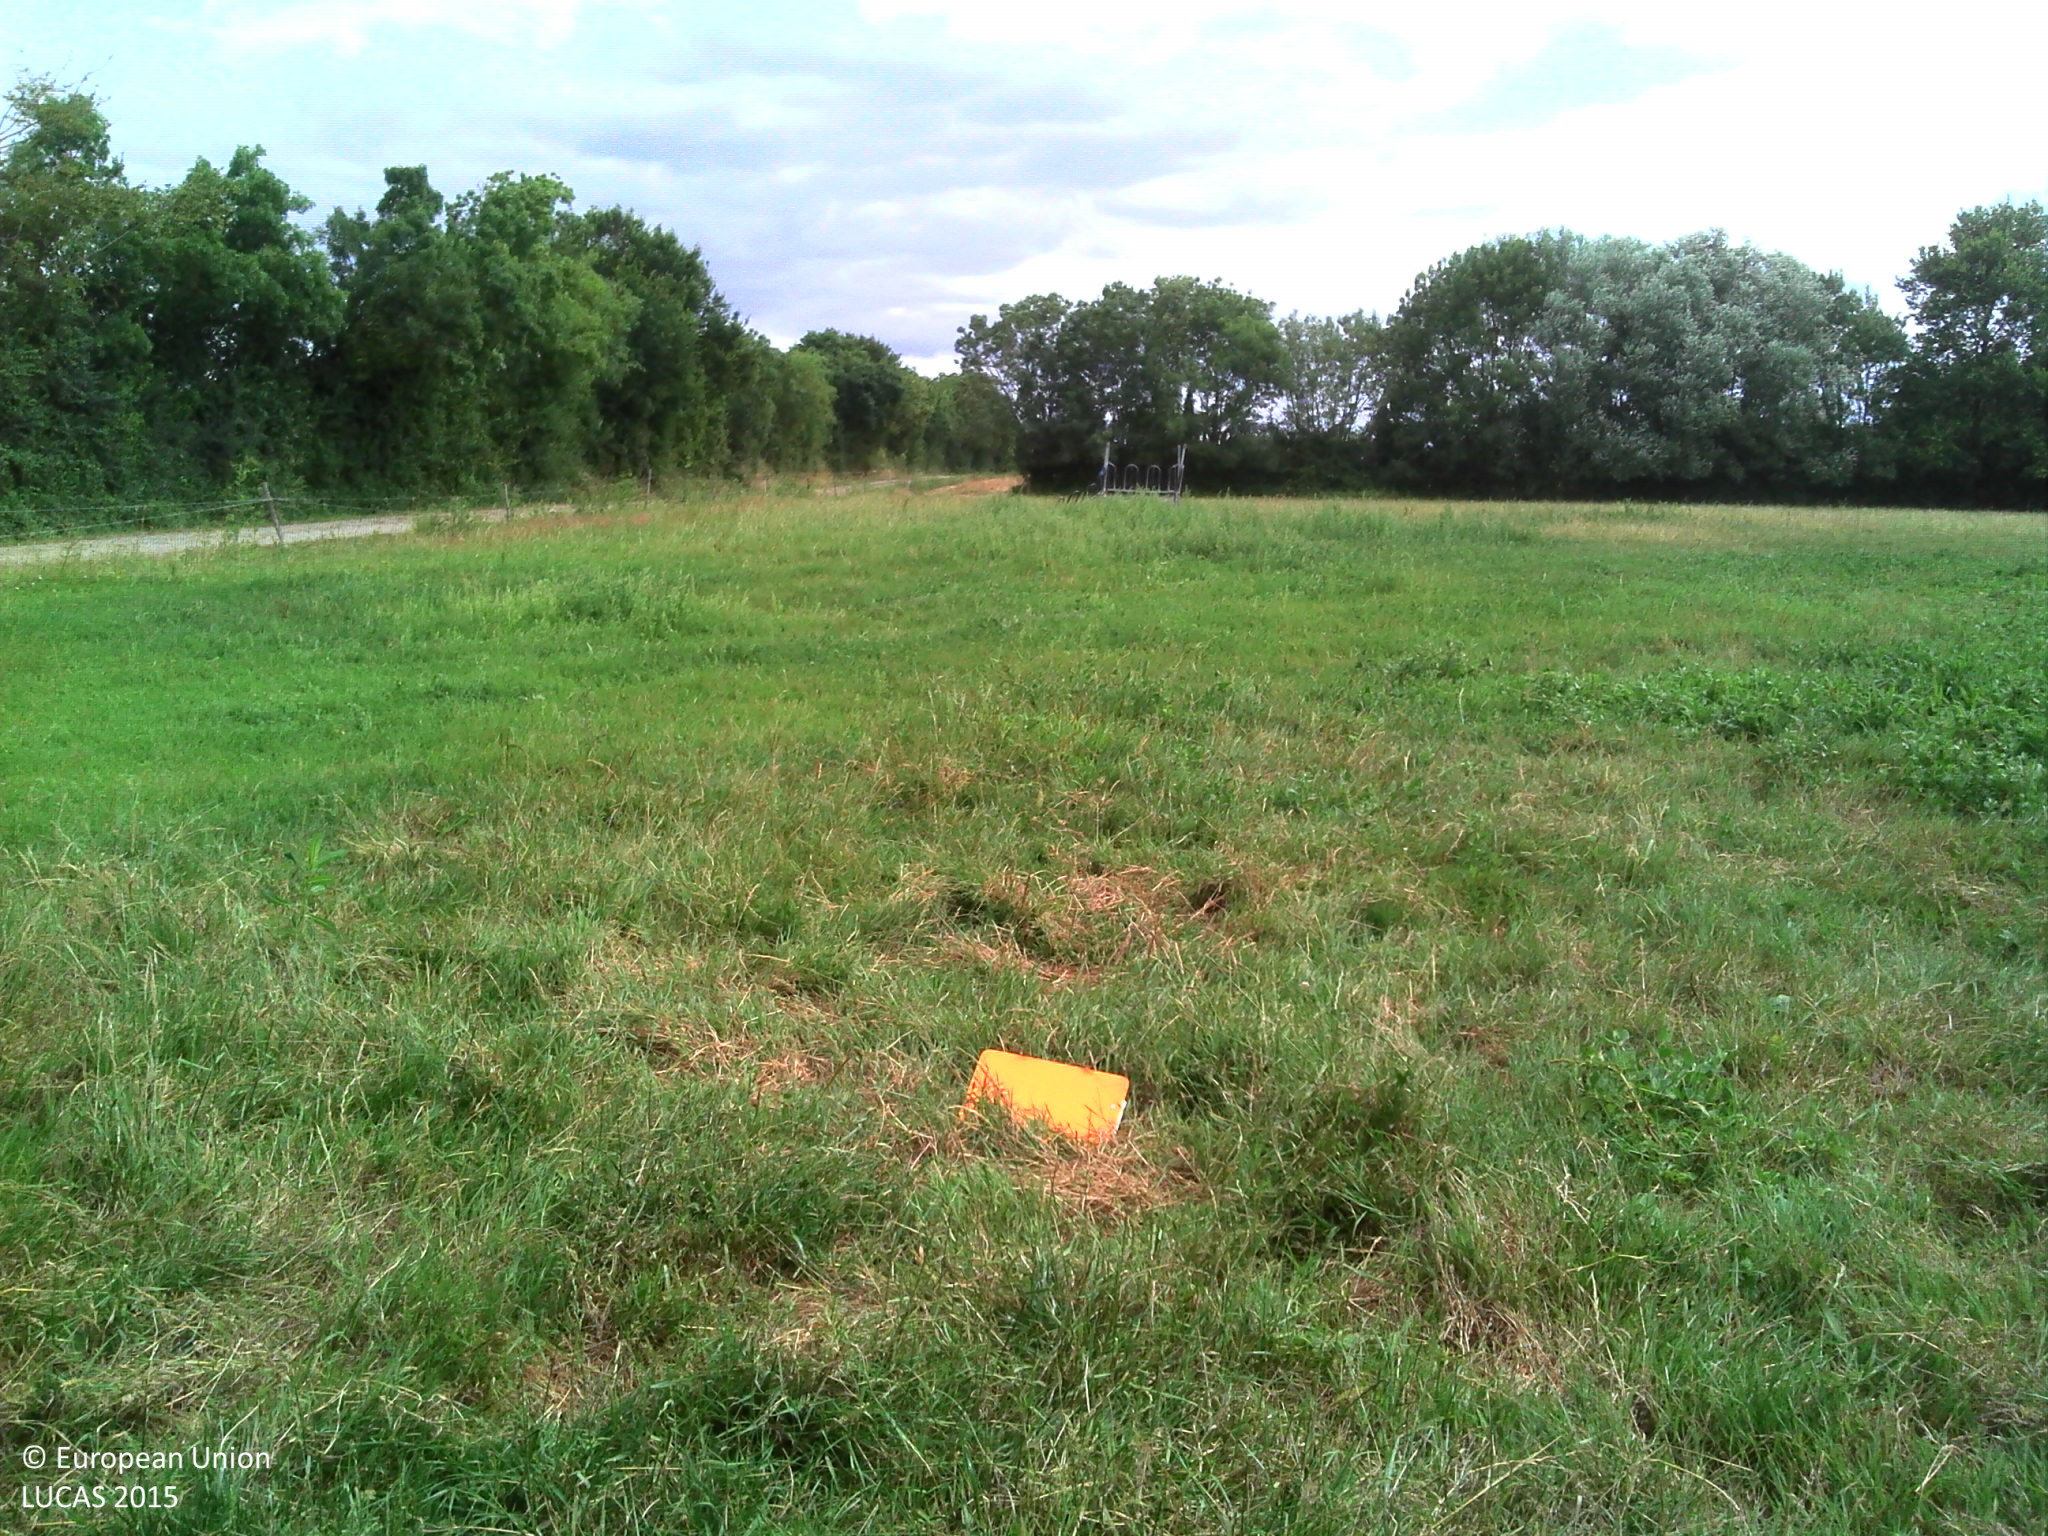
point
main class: Grassland
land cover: Grassland without tree/shrub cover
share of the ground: > 75 %
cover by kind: herbaceous plants 100 %
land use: Agriculture (excluding fallow land and kitchen gardens)
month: July
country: FR
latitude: 47.0533
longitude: -1.6935
